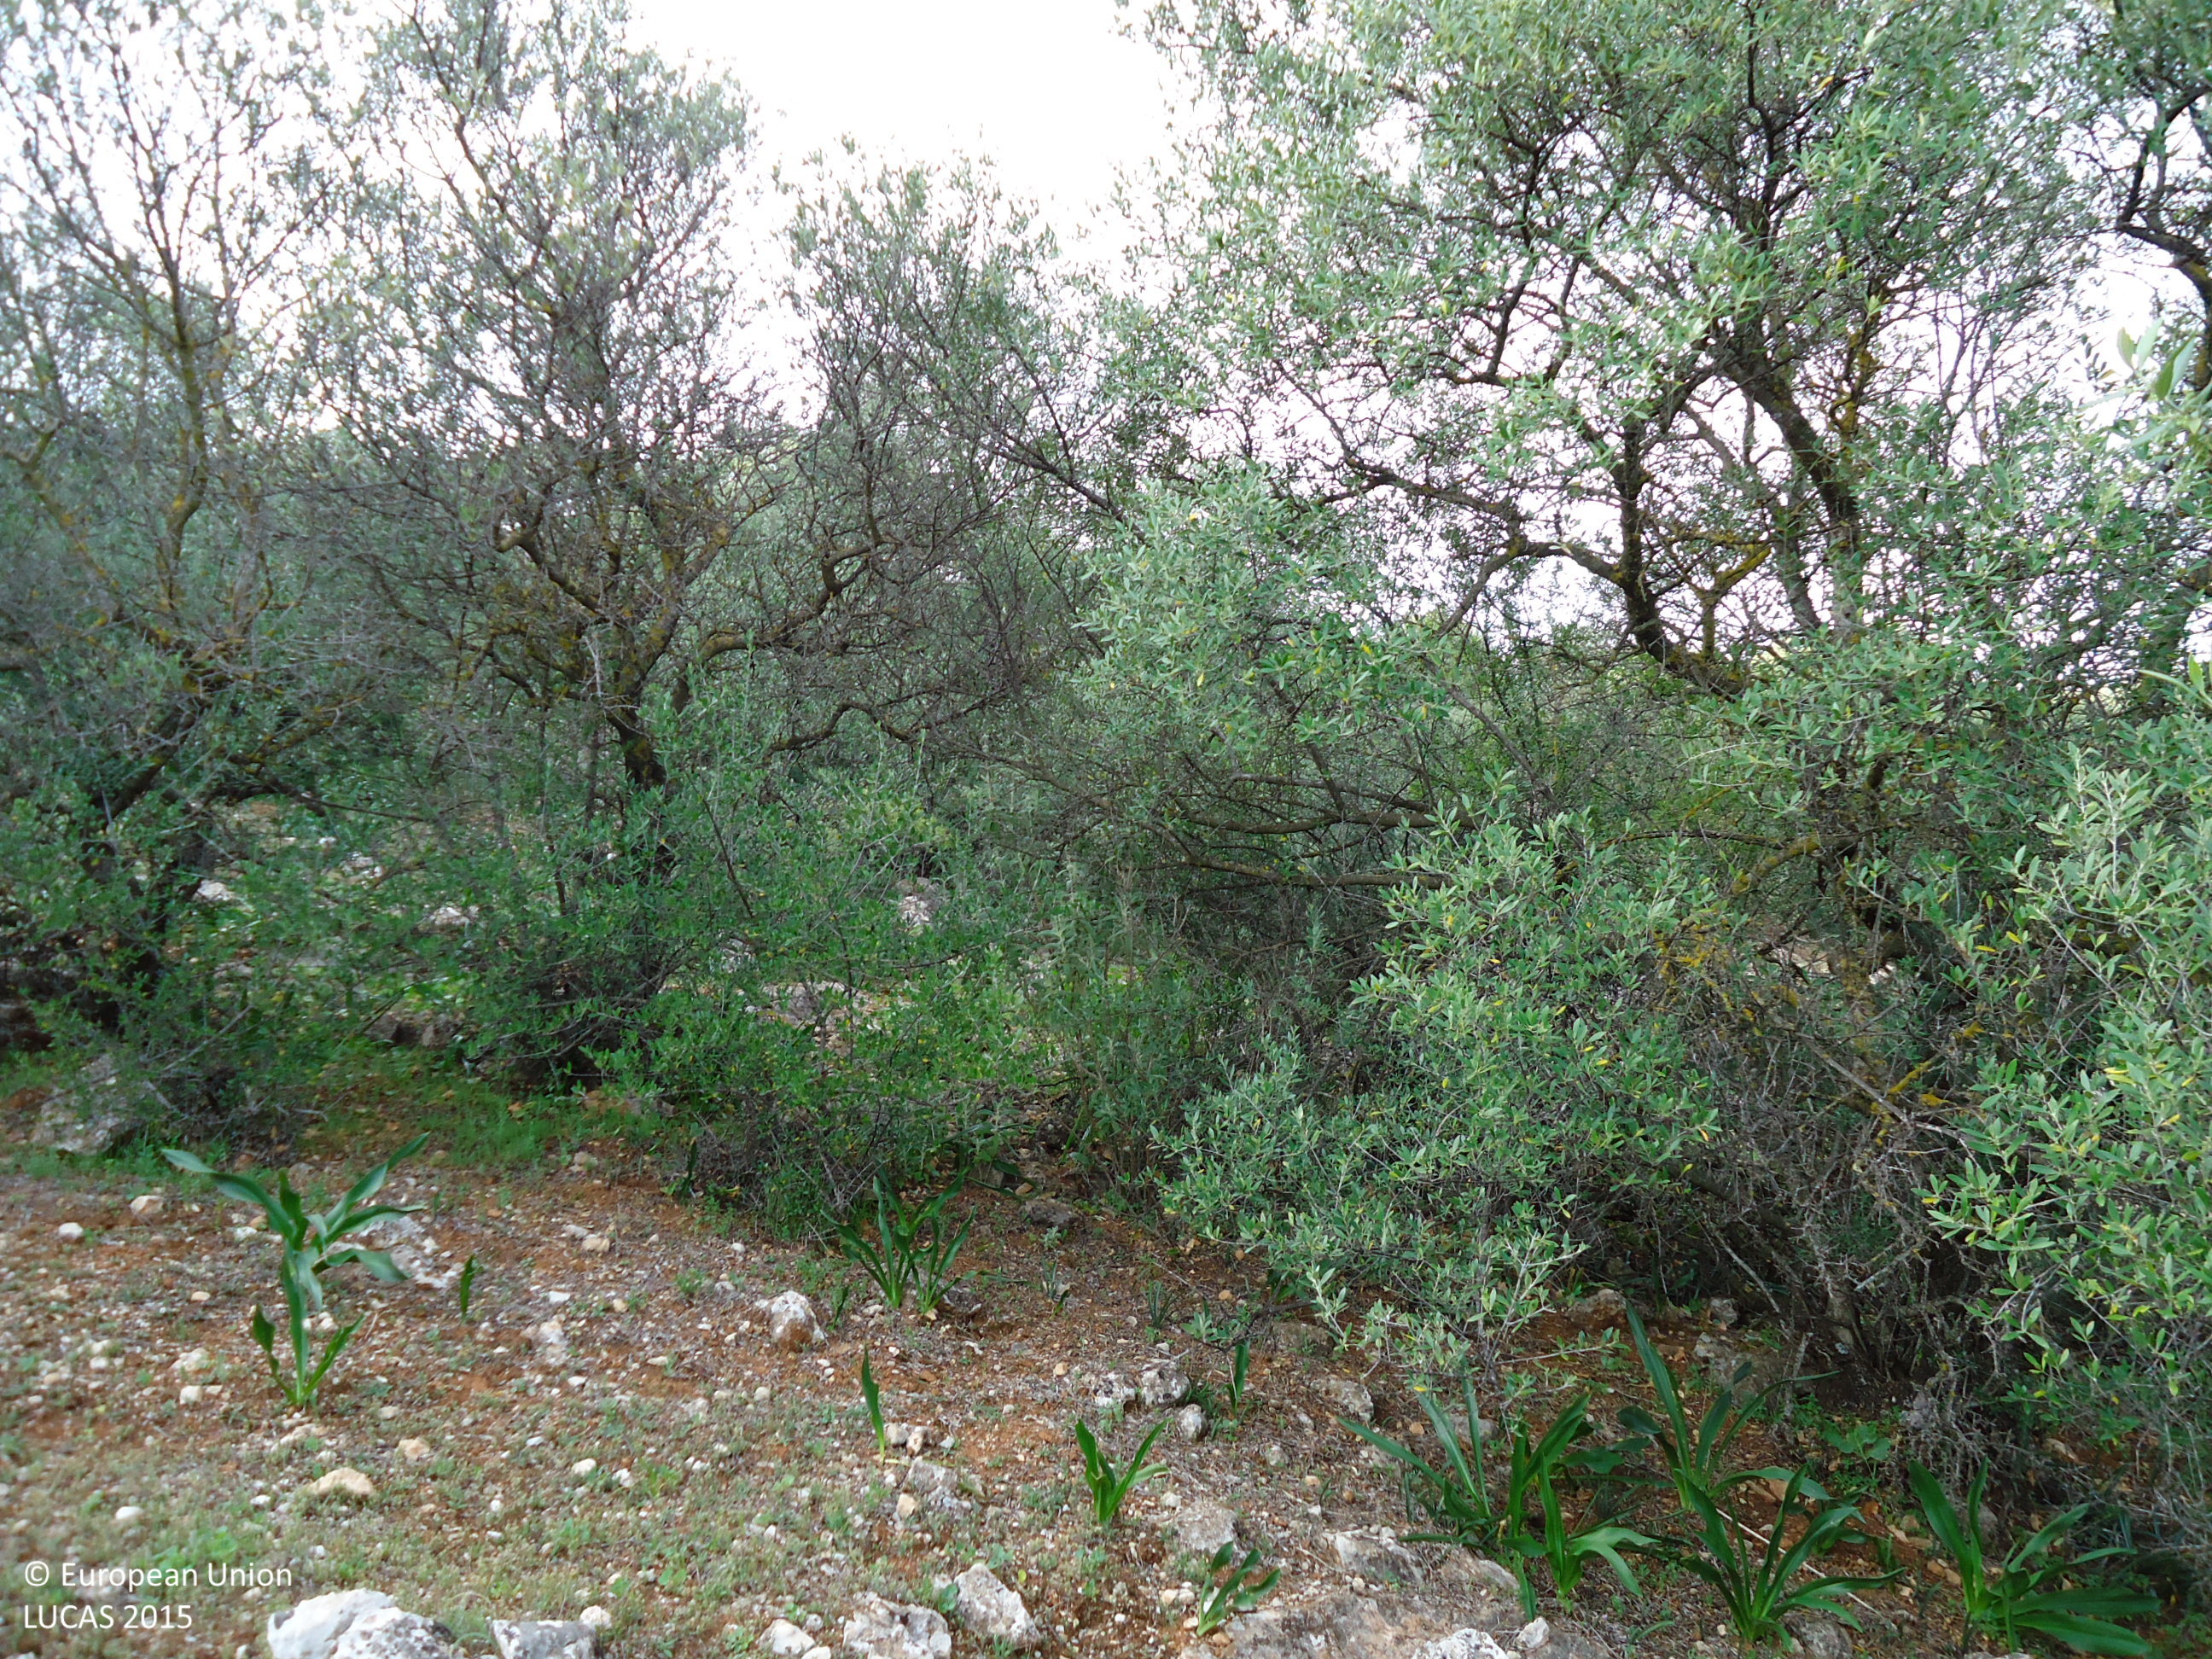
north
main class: Shrubland
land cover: Shrubland with sparse tree cover
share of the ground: 25 - 50 %
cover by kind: herbaceous plants 60 %, shrubs 35 %, broadleaved forest trees 5 %
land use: Semi-natural and natural areas not in use
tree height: < 5 m
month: April
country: ES
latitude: 37.1659
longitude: -4.8341
